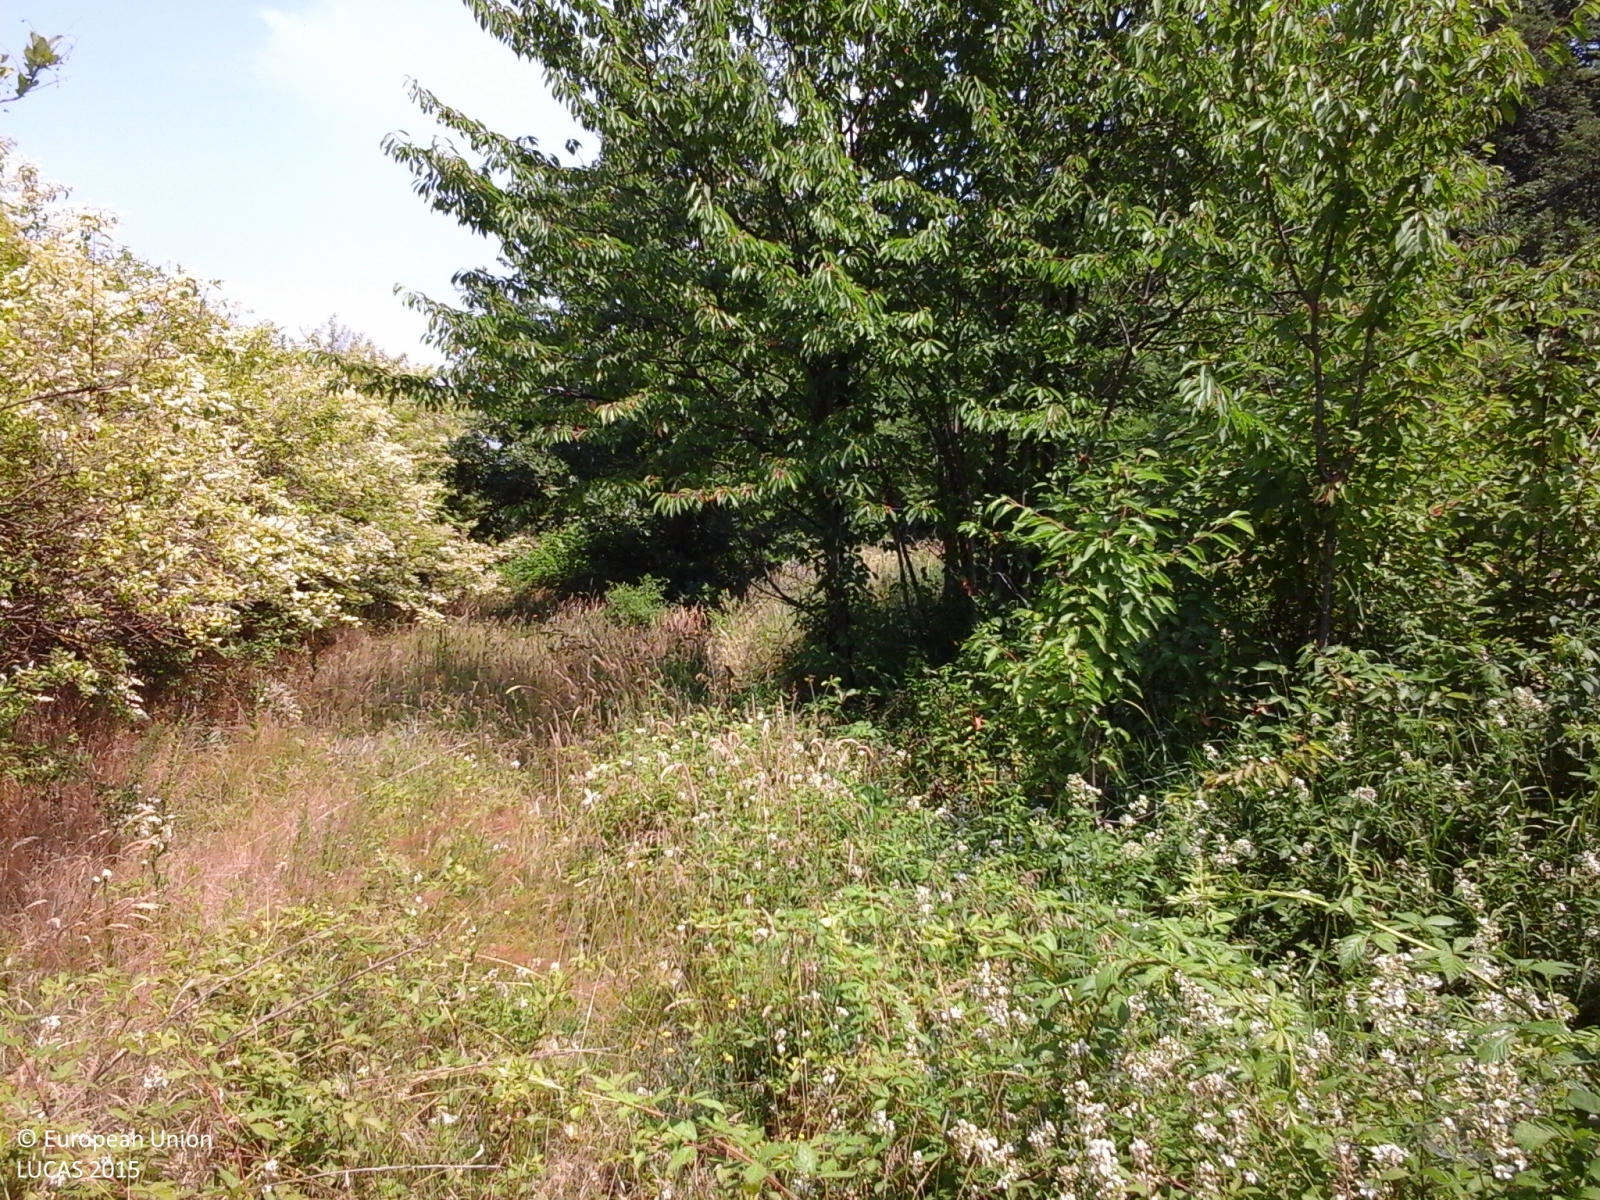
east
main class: Grassland
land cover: Spontaneously vegetated surfaces
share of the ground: > 75 %
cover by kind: herbaceous plants 100 %
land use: Abandoned areas
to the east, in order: Spontaneously vegetated surfaces; Fences; Abandoned hedges; Grassland without tree/shrub cover; Abandoned hedges; Grassland without tree/shrub cover; Tracks; Grassland without tree/shrub cover; Tracks; Broadleaved woodland; Inland fresh running water; Broadleaved woodland
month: June
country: IT
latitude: 44.7206
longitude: 8.6519
